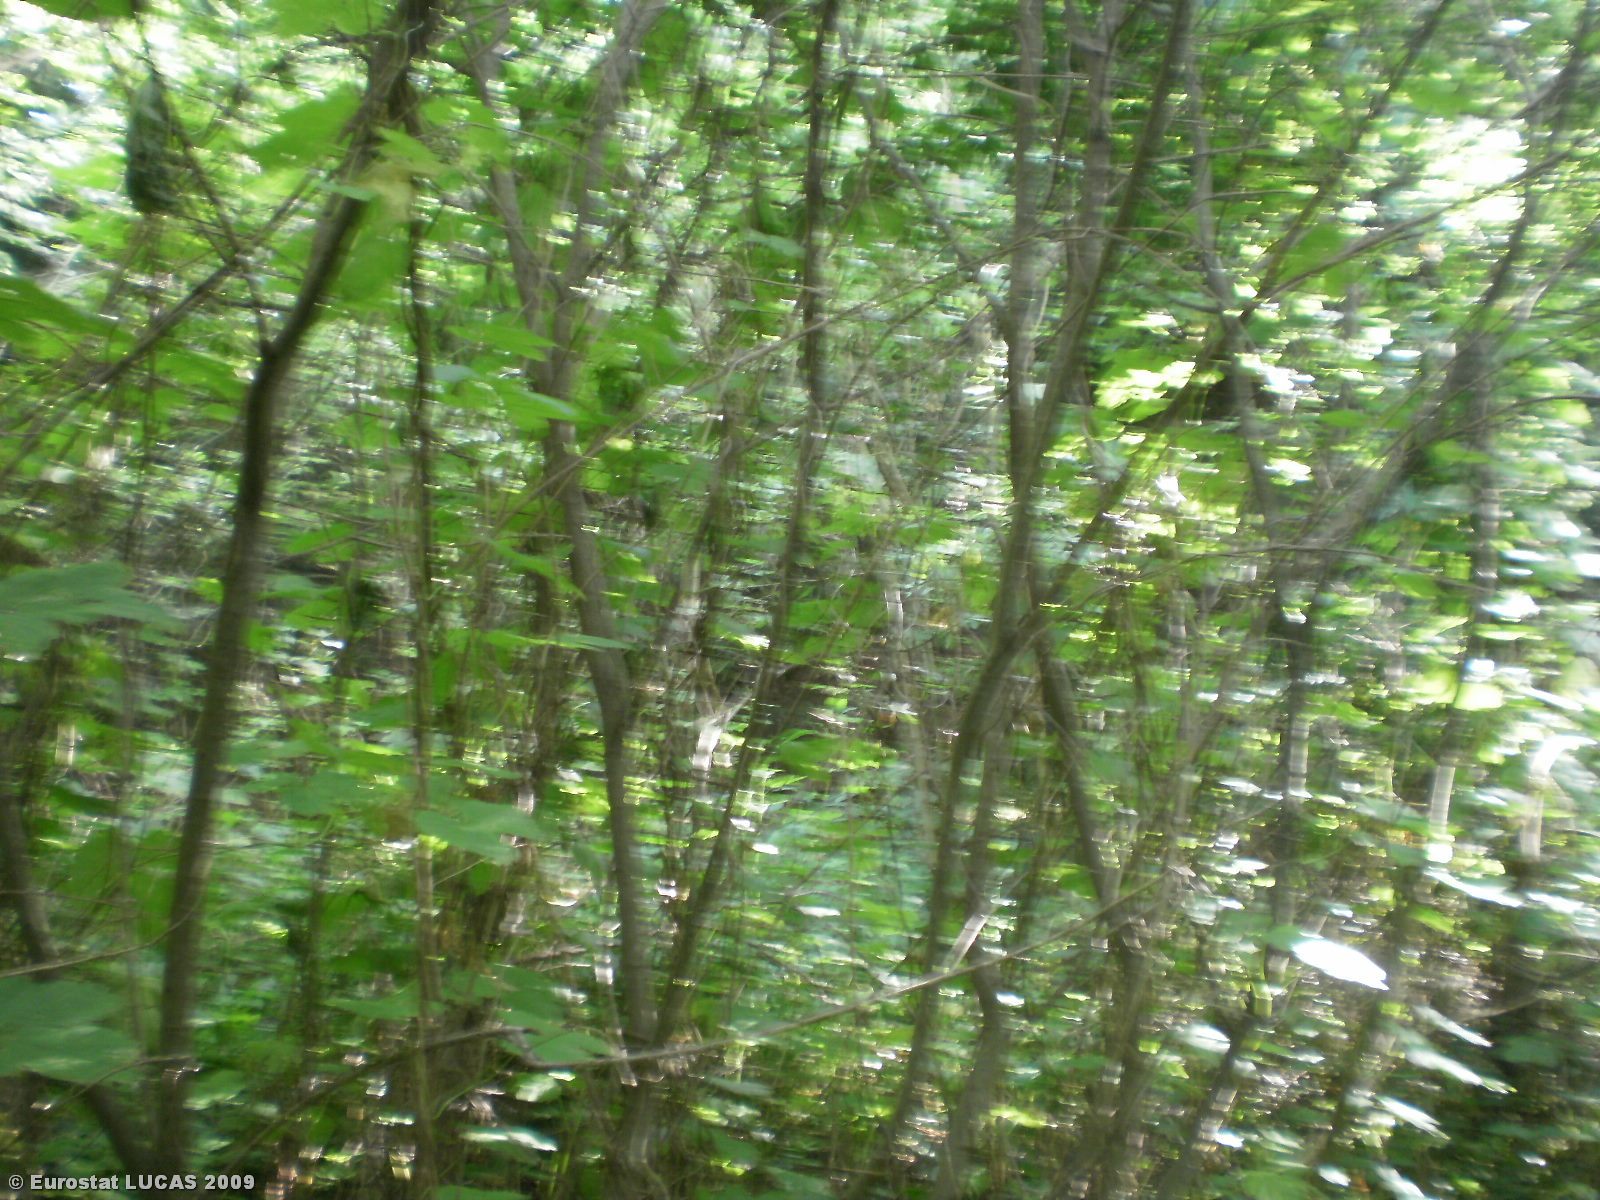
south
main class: Woodland
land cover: Broadleaved woodland
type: non-riverine alder, birch or aspen forest
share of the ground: 50 - 75 %
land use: Forestry
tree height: > 5 m
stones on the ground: < 10 %
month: July
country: LT
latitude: 55.8137
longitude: 25.5887
